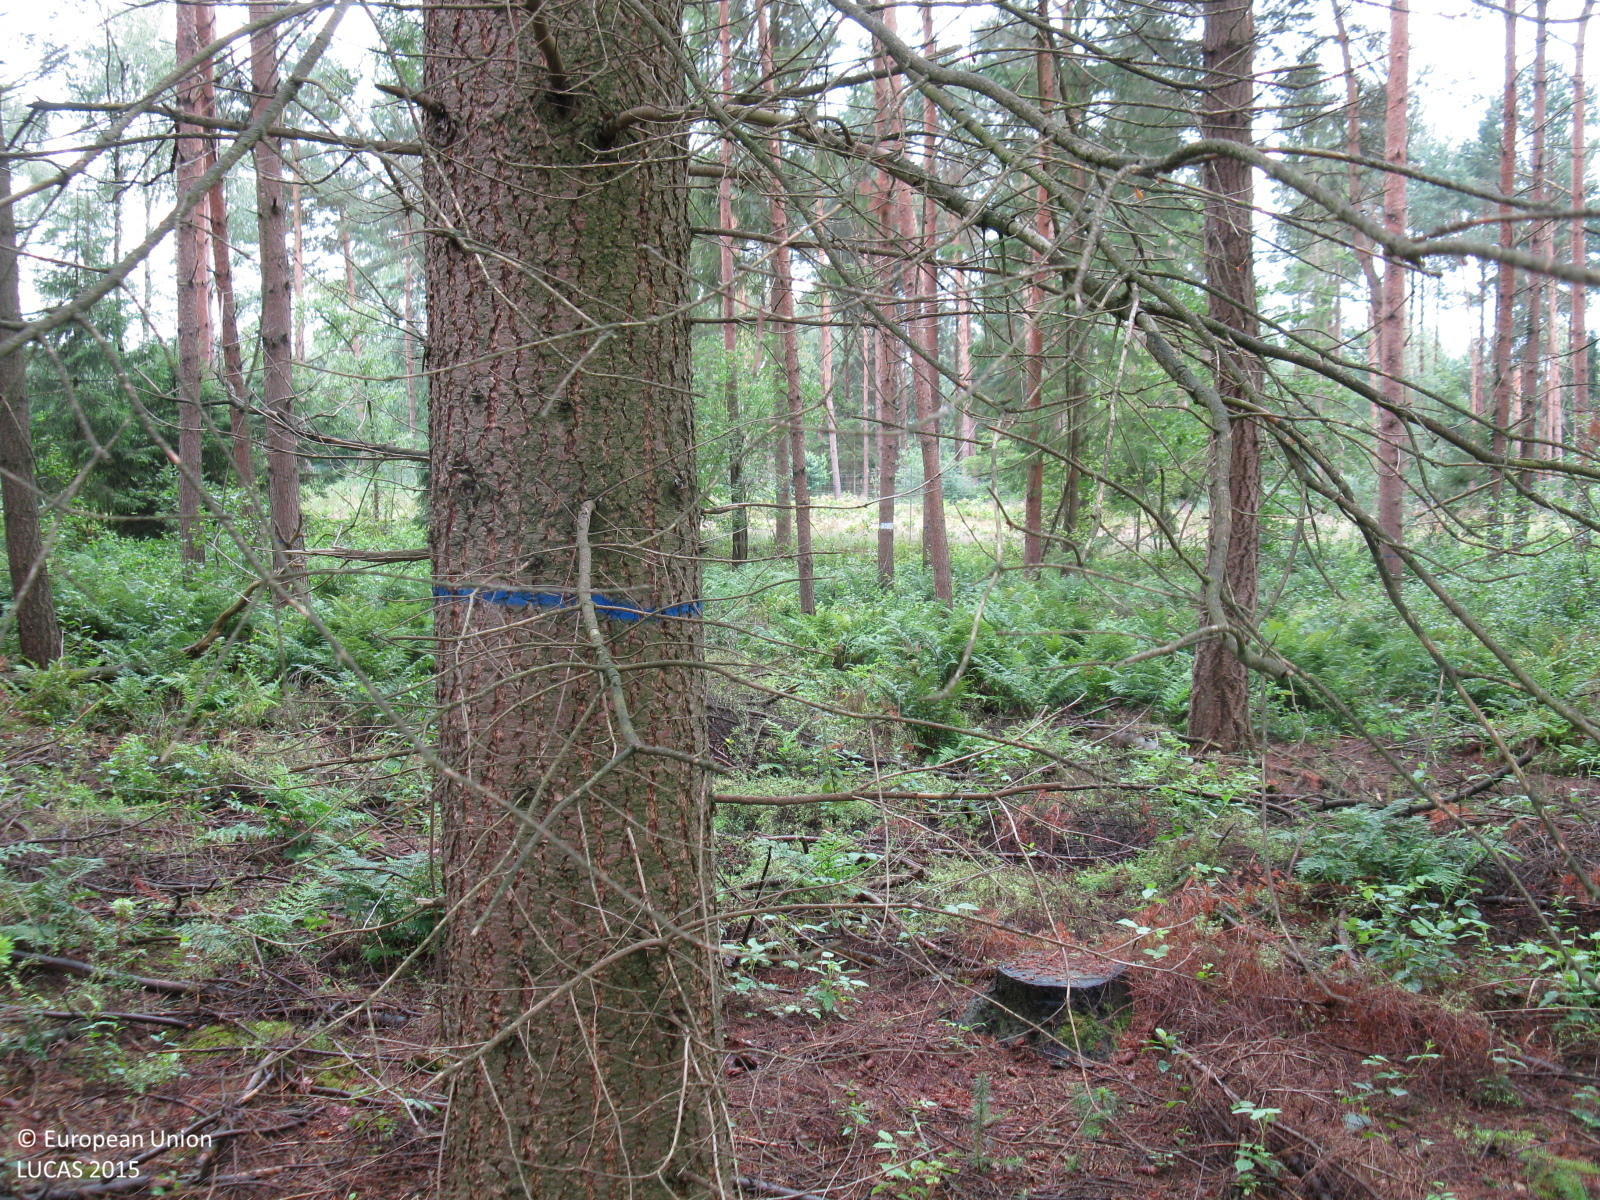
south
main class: Woodland
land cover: Other coniferous woodland
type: hemiboreal forest and nemoral coniferous forest and mixed broadleaved-coniferous forest
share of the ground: > 75 %
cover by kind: coniferous forest trees 85 %, herbaceous plants 10 %, shrubs 5 %
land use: Forestry
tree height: > 5 m
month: July
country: DE
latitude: 52.9256
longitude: 8.5279
